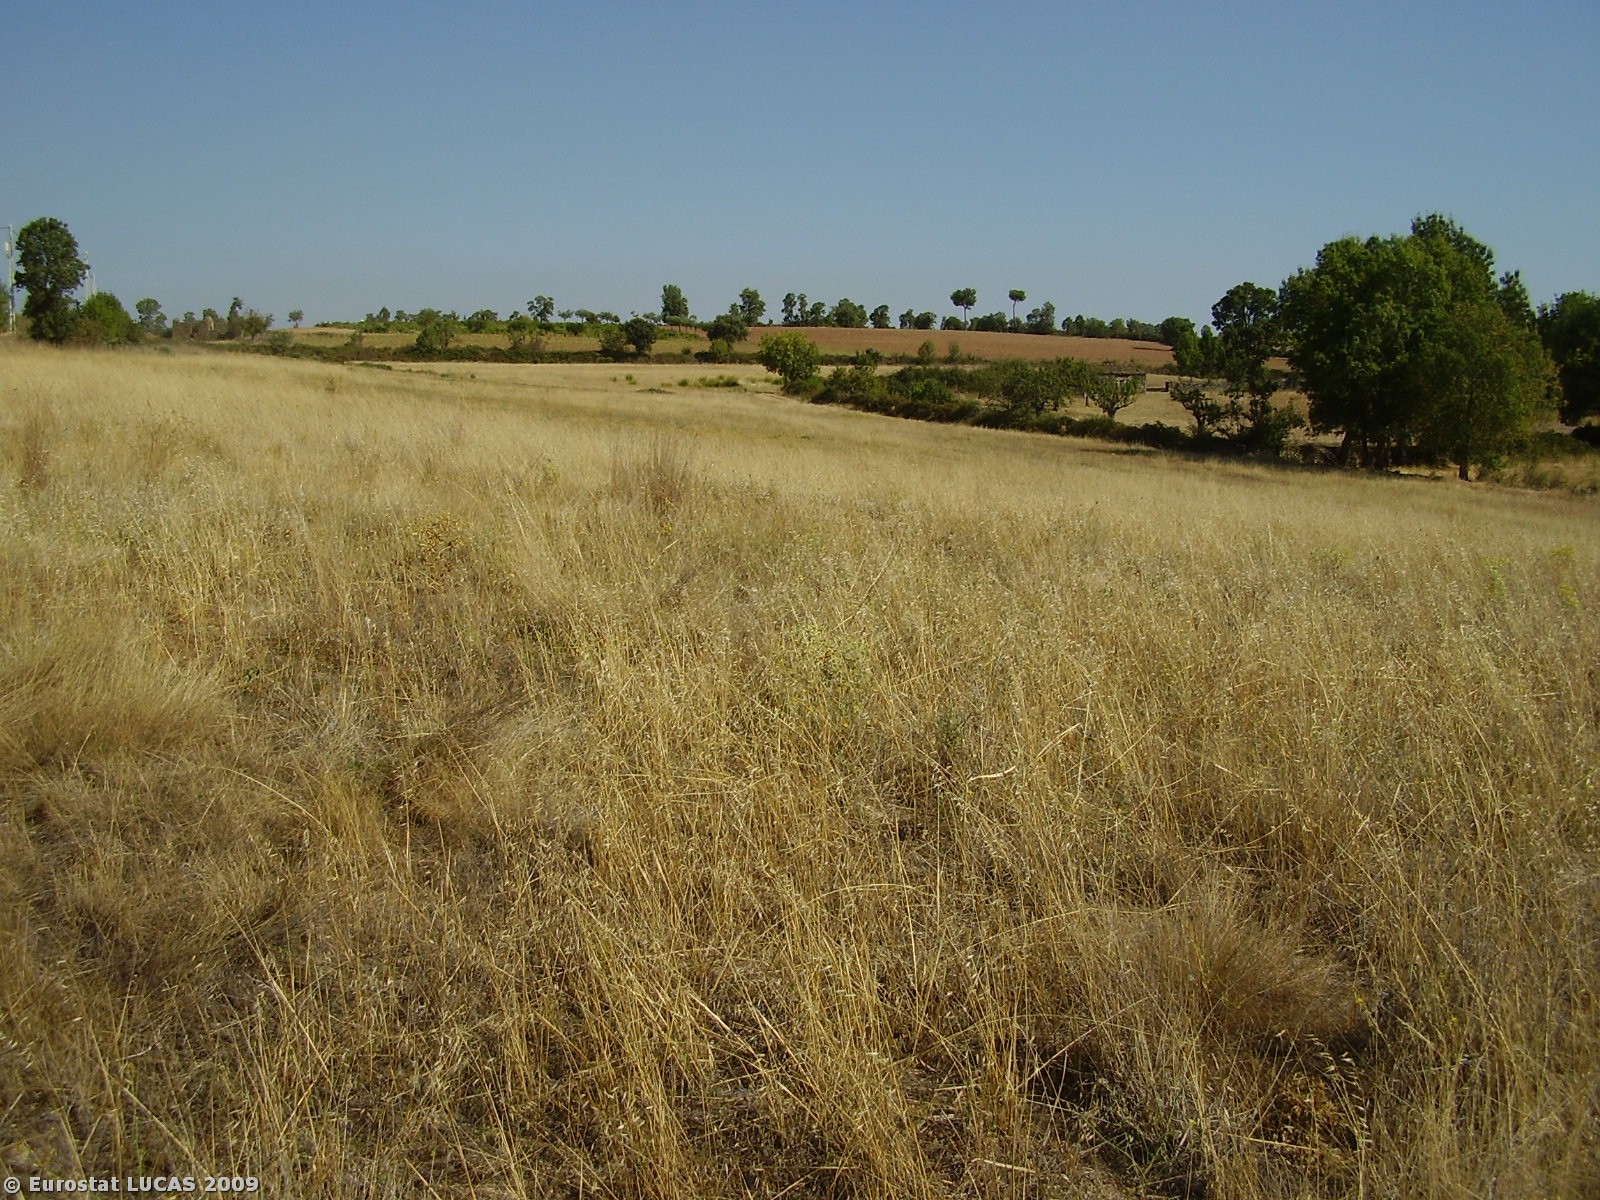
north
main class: Grassland
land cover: Grassland without tree/shrub cover
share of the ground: > 75 %
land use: Fallow land
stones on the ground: > 50 %
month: August
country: PT
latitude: 41.3431
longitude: -6.7291
